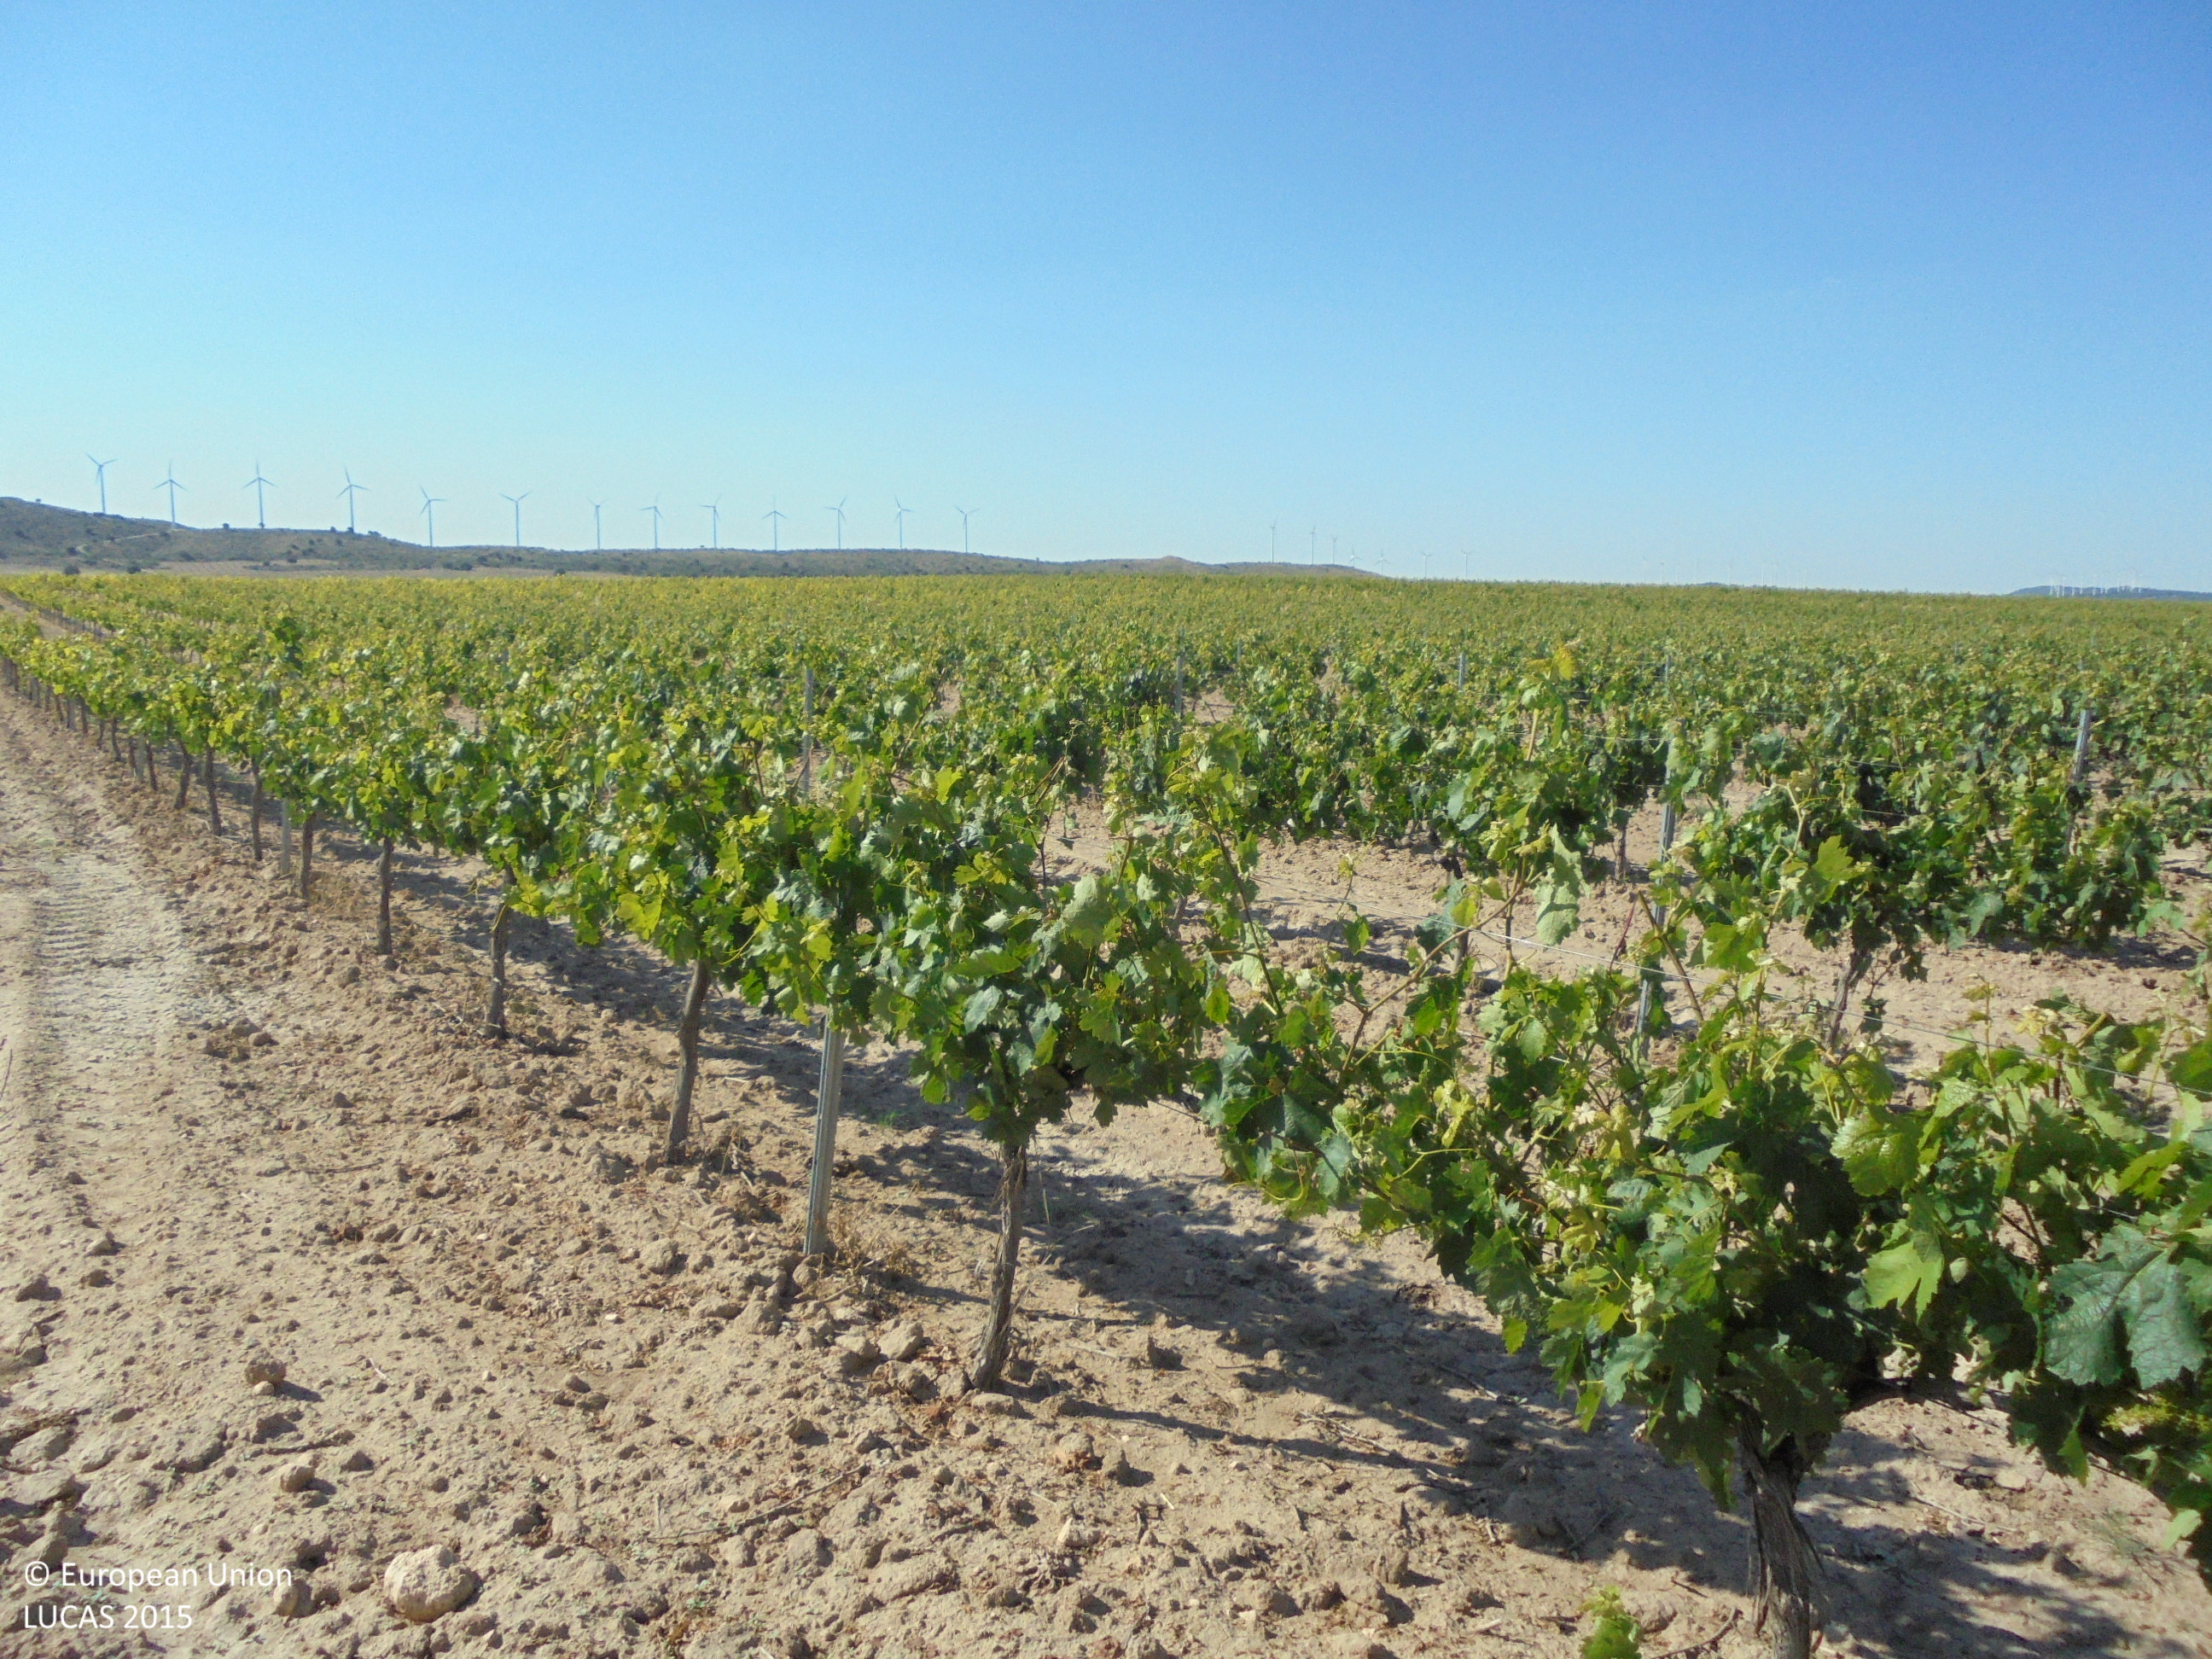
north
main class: Cropland
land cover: Vineyards
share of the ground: 10 - 25 %
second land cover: Other bare soil
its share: > 75 %
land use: Agriculture (excluding fallow land and kitchen gardens)
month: June
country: ES
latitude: 38.7579
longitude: -1.7228
